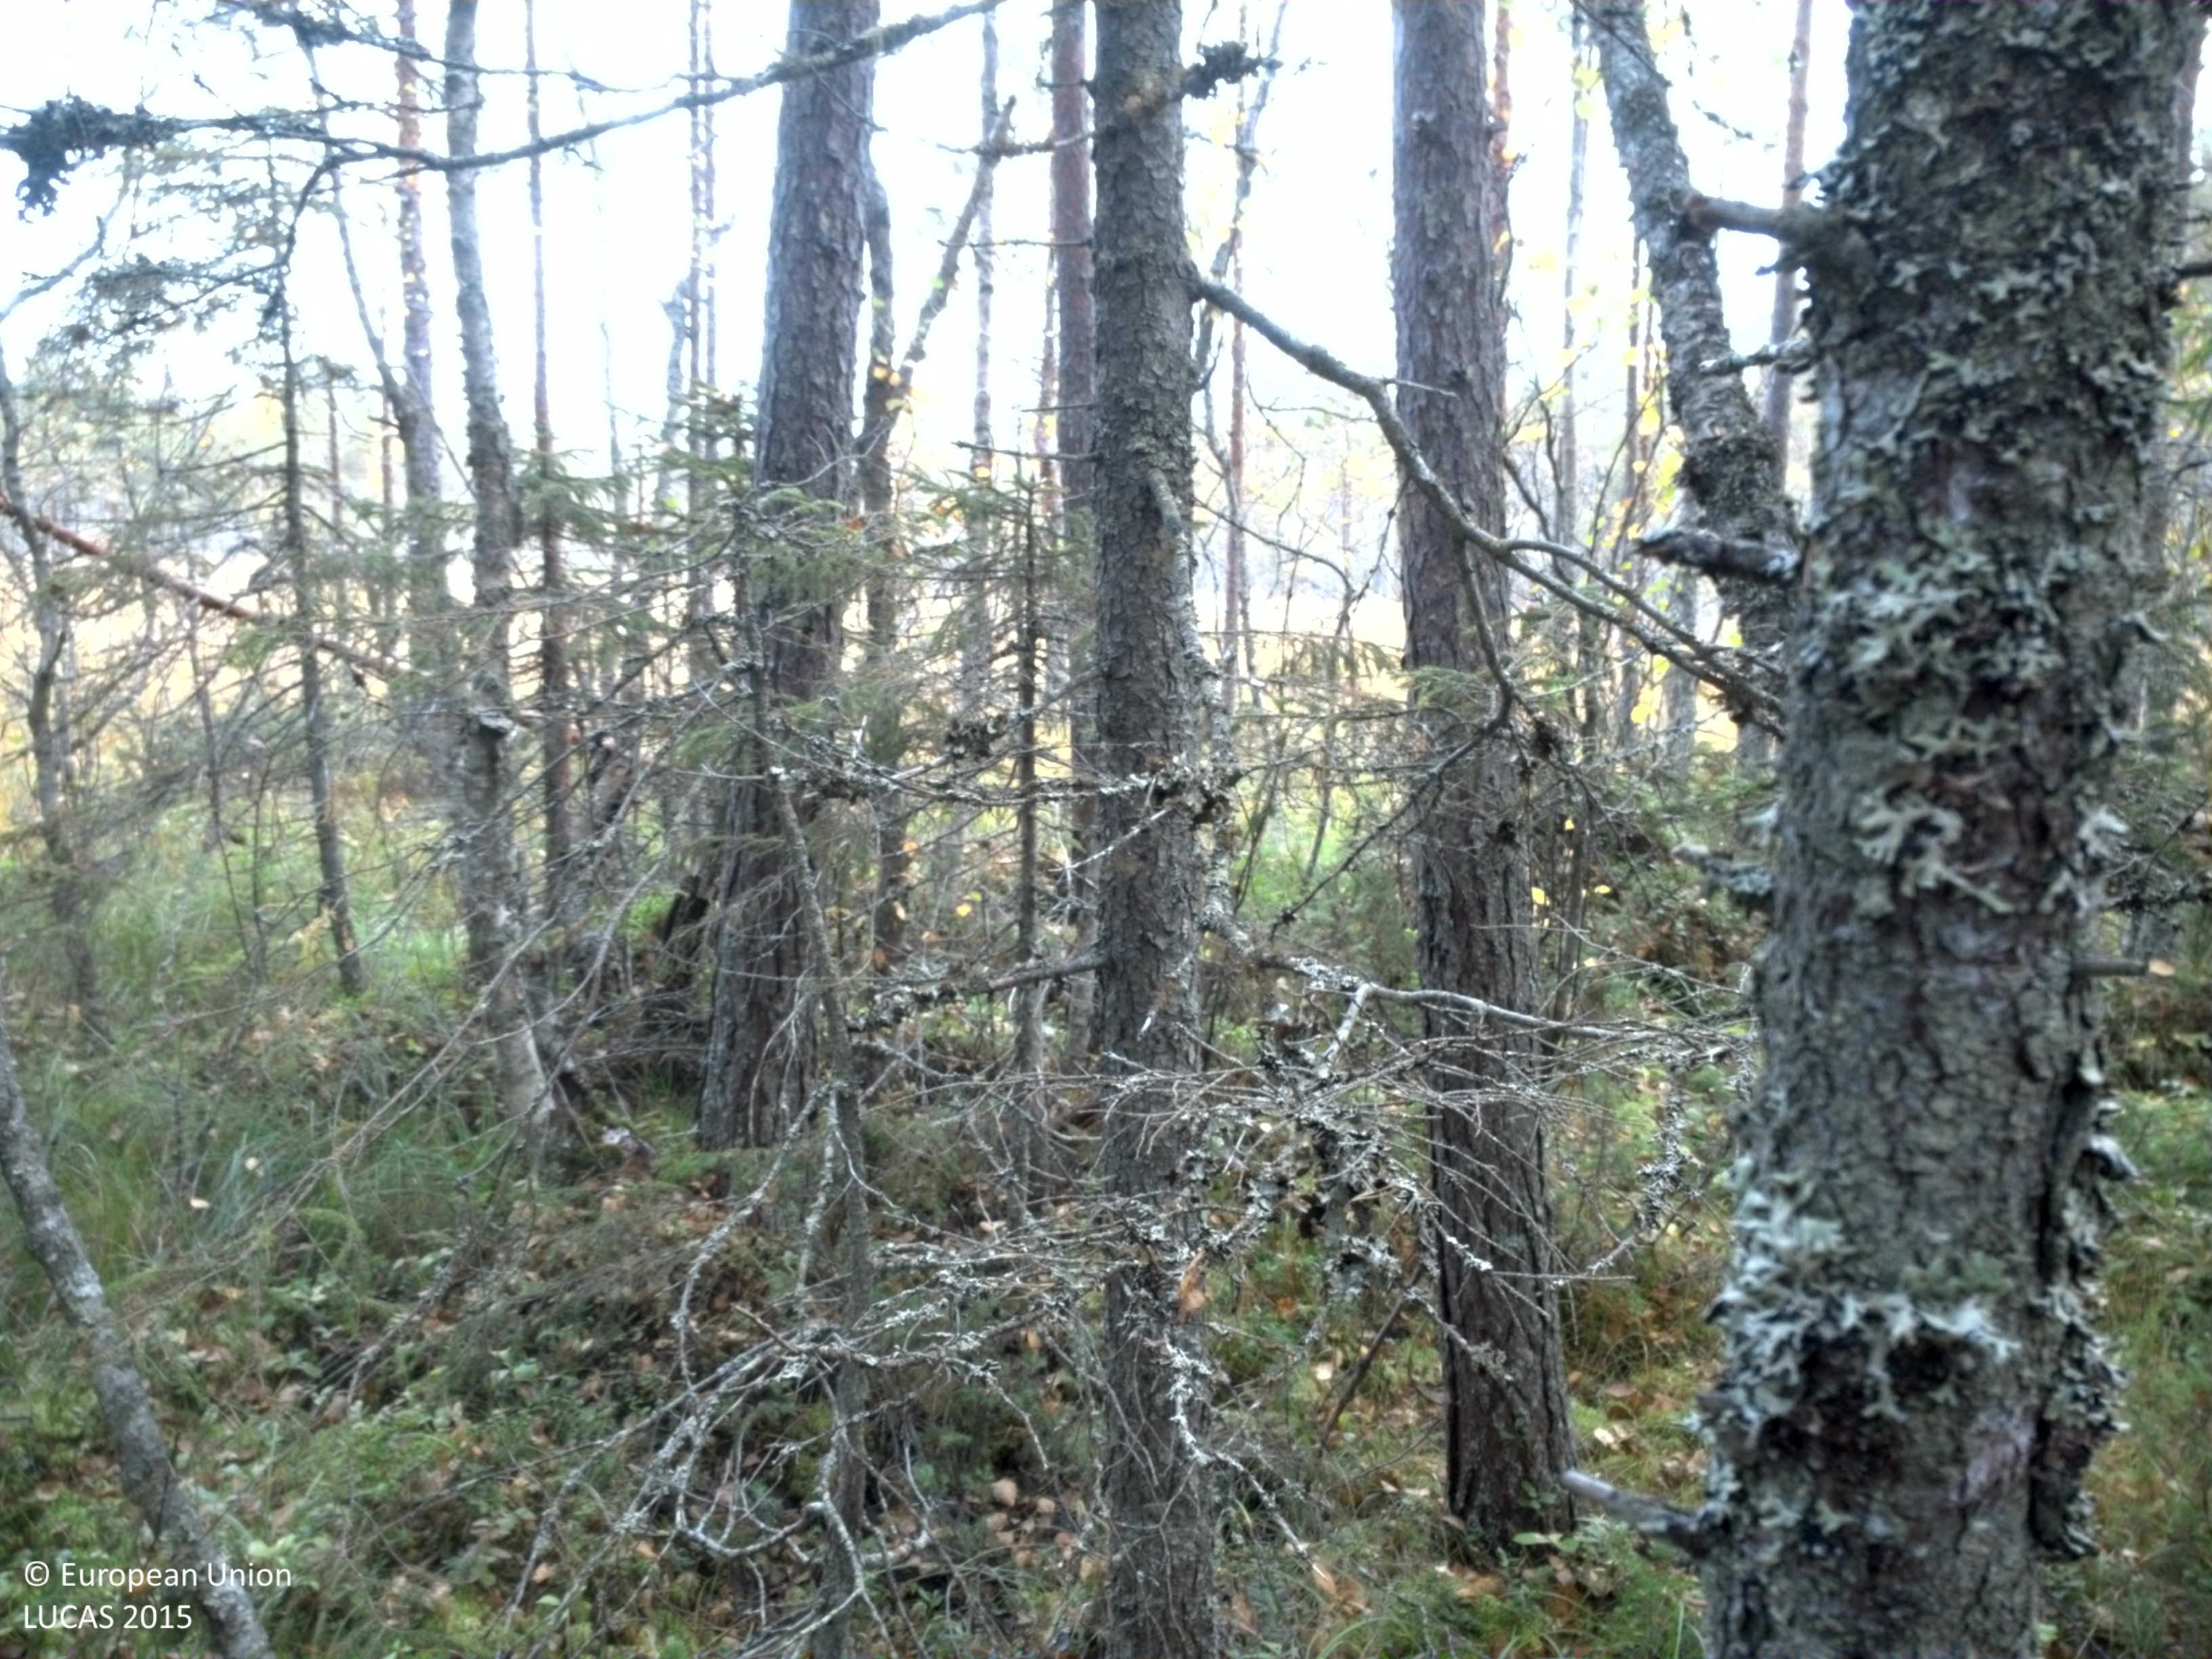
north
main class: Woodland
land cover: Pine dominated mixed woodland
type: boreal forest
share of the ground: 25 - 50 %
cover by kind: shrubs 45 %, coniferous forest trees 30 %, broadleaved forest trees 15 %, lichens and mosses 10 %
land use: Forestry
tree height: > 5 m
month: September
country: SE
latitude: 65.5328
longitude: 22.0316
